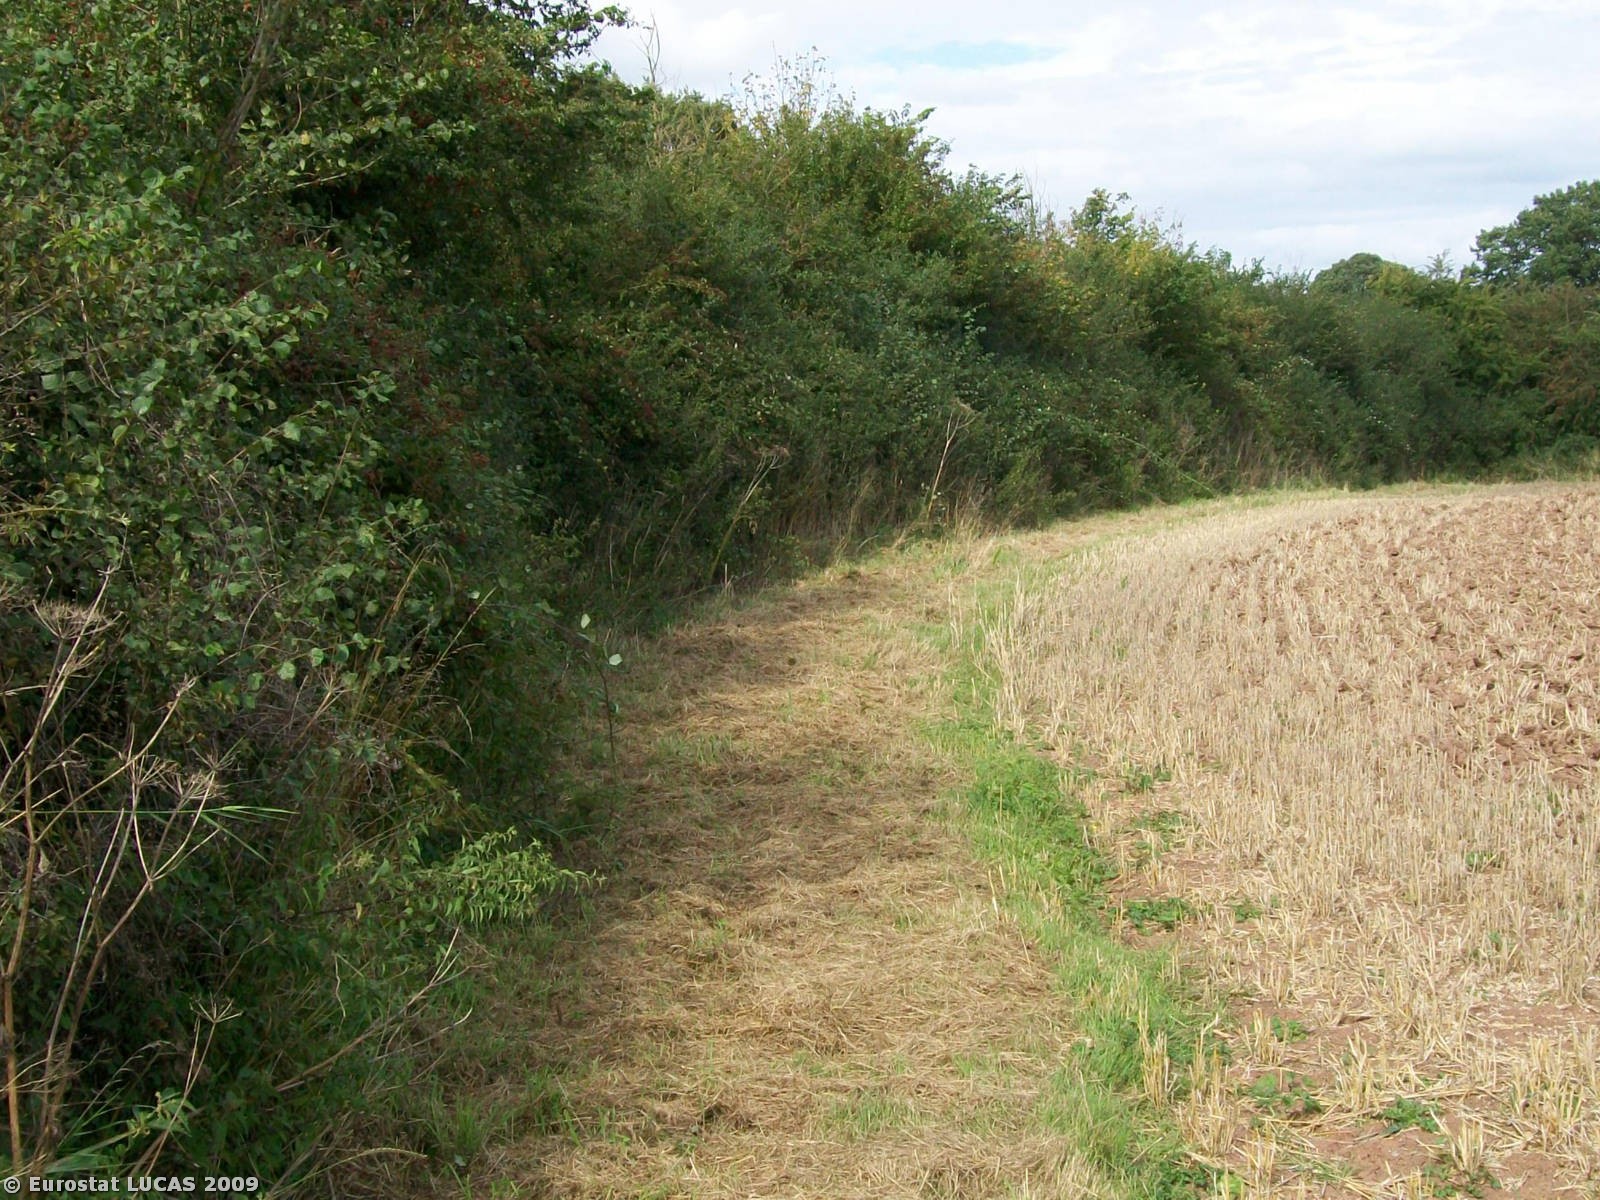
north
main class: Cropland
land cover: Common wheat
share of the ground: < 10 %
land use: Agriculture (excluding fallow land and kitchen gardens)
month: August
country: GB
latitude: 51.8733
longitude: -2.3667
